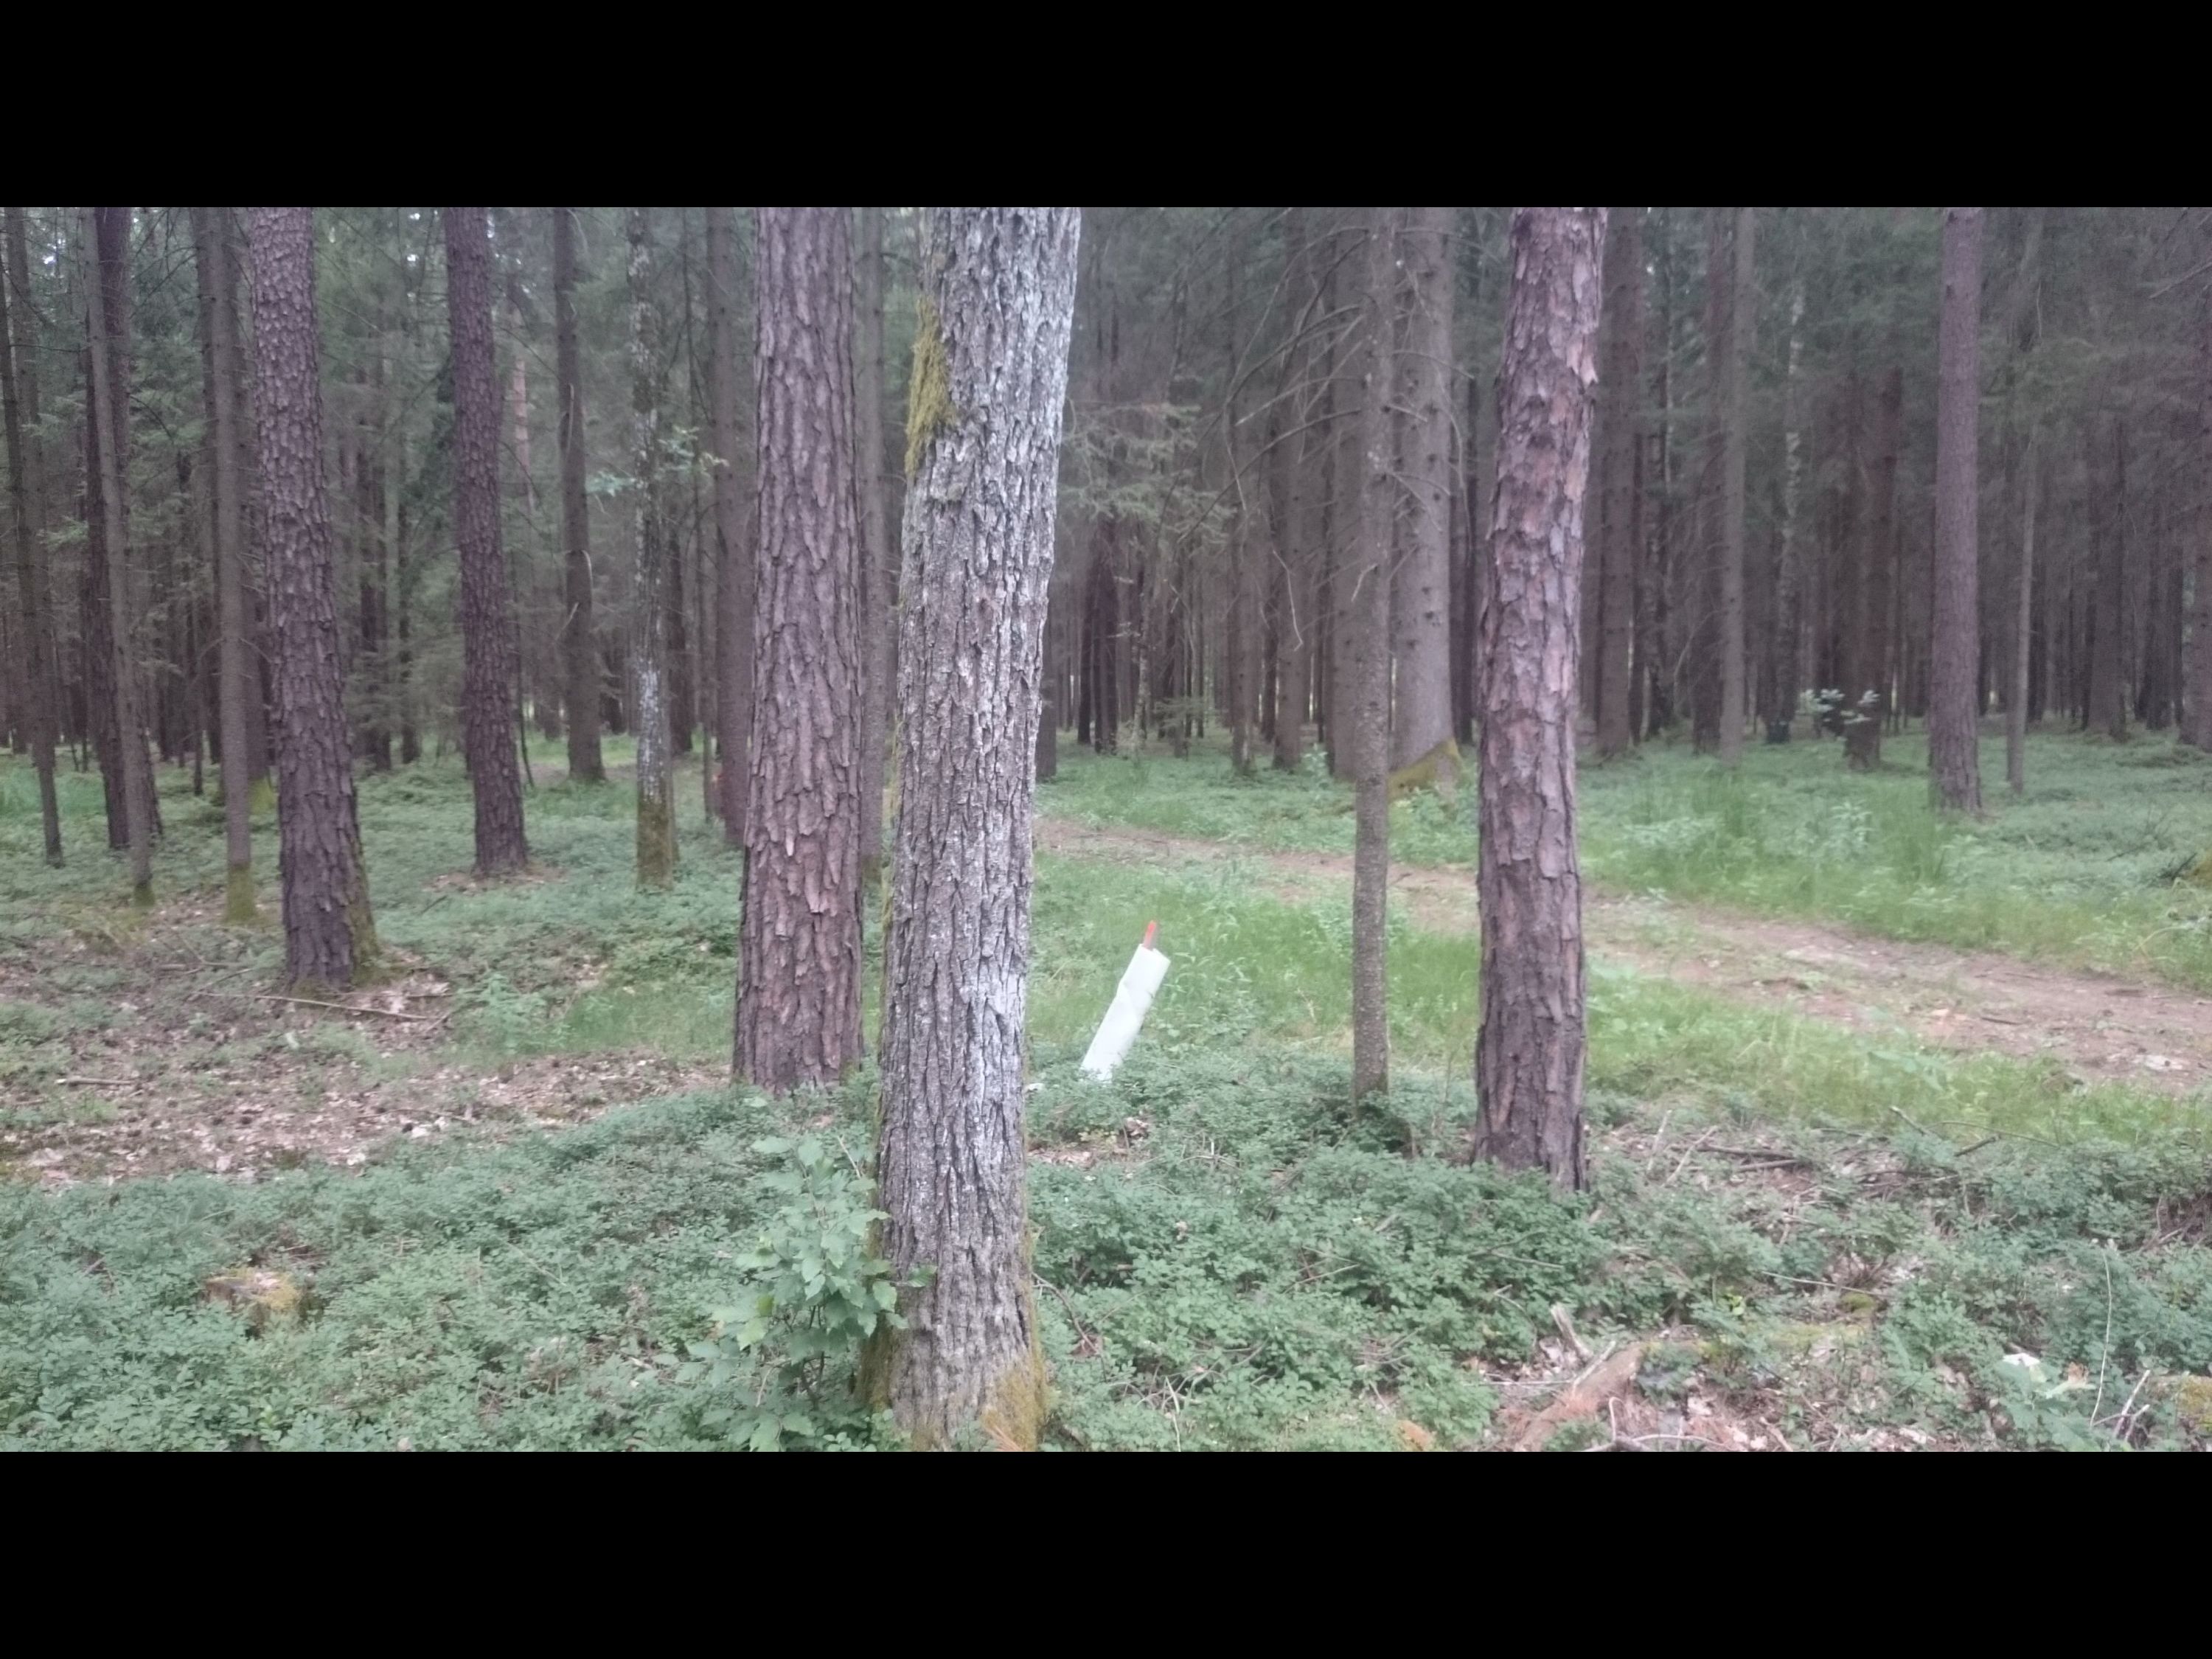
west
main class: Woodland
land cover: Pine dominated coniferous woodland
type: hemiboreal forest and nemoral coniferous forest and mixed broadleaved-coniferous forest
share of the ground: 50 - 75 %
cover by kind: coniferous forest trees 60 %, shrubs 30 %, unconsolidated bare surface 10 %
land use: Forestry
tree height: > 5 m
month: July
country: AT
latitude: 47.1038
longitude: 15.9966
